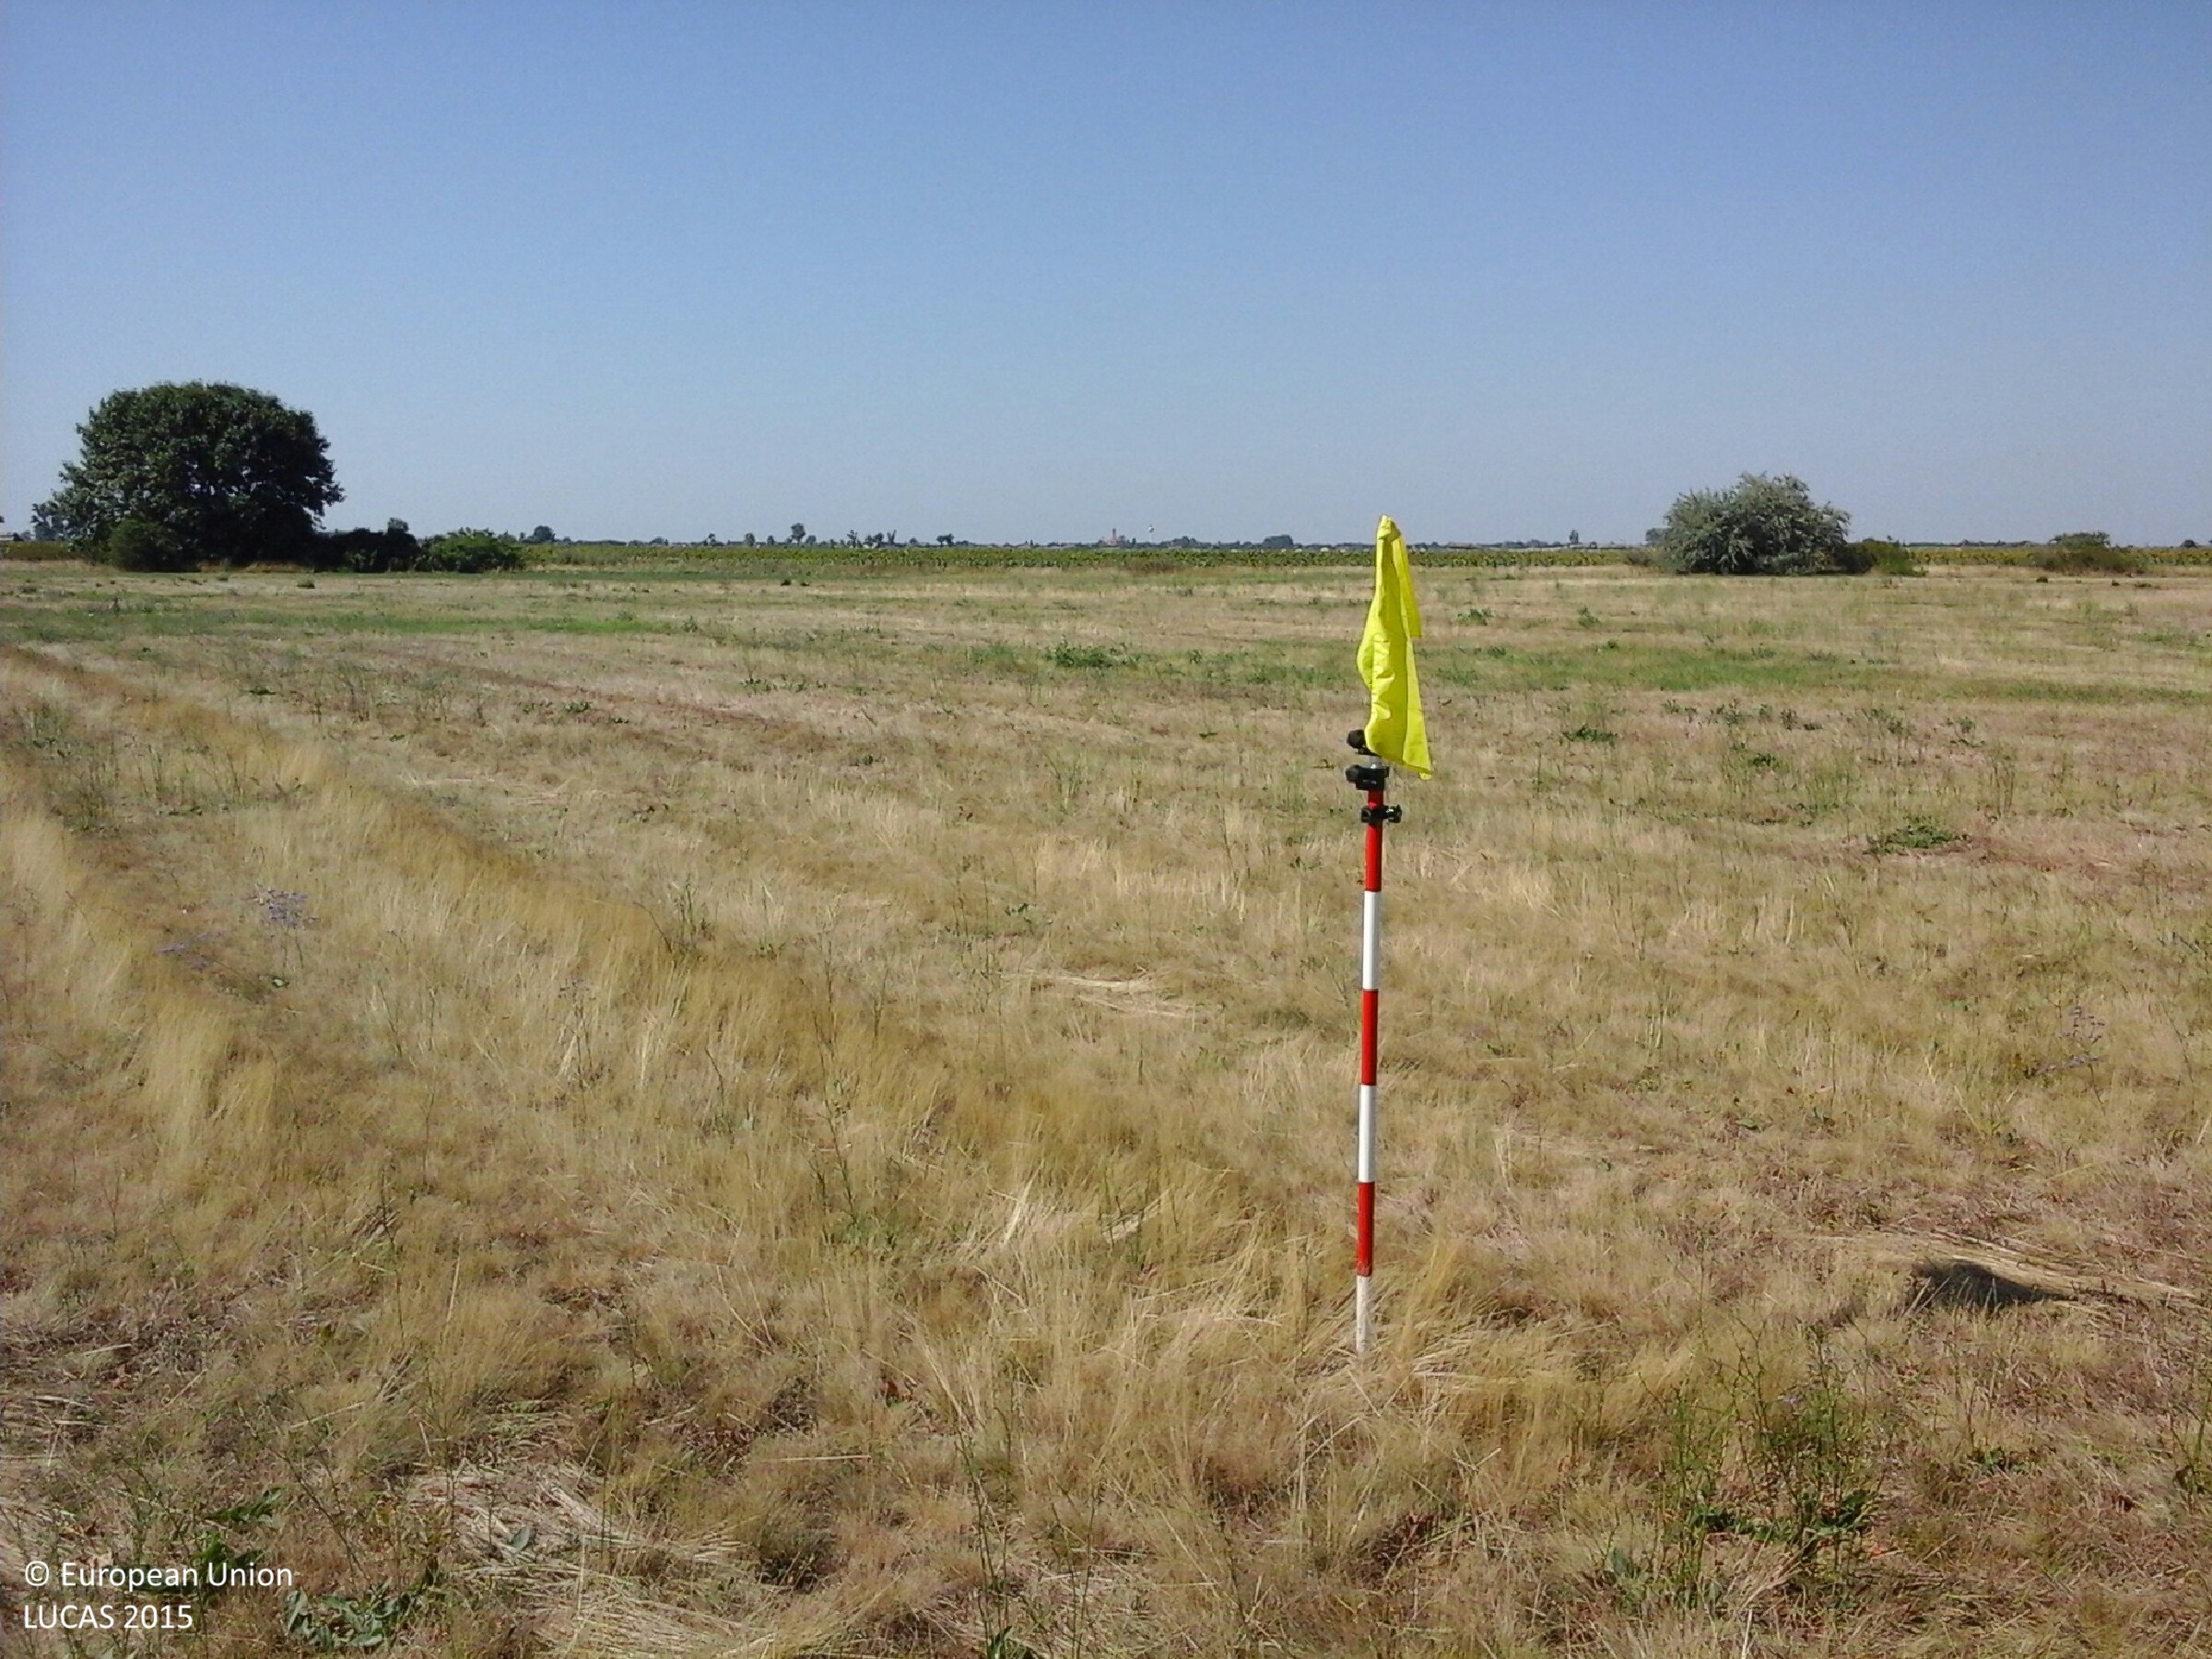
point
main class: Grassland
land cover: Grassland without tree/shrub cover
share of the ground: > 75 %
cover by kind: herbaceous plants 100 %
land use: Agriculture (excluding fallow land and kitchen gardens)
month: July
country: HU
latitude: 47.5888
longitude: 20.5504
